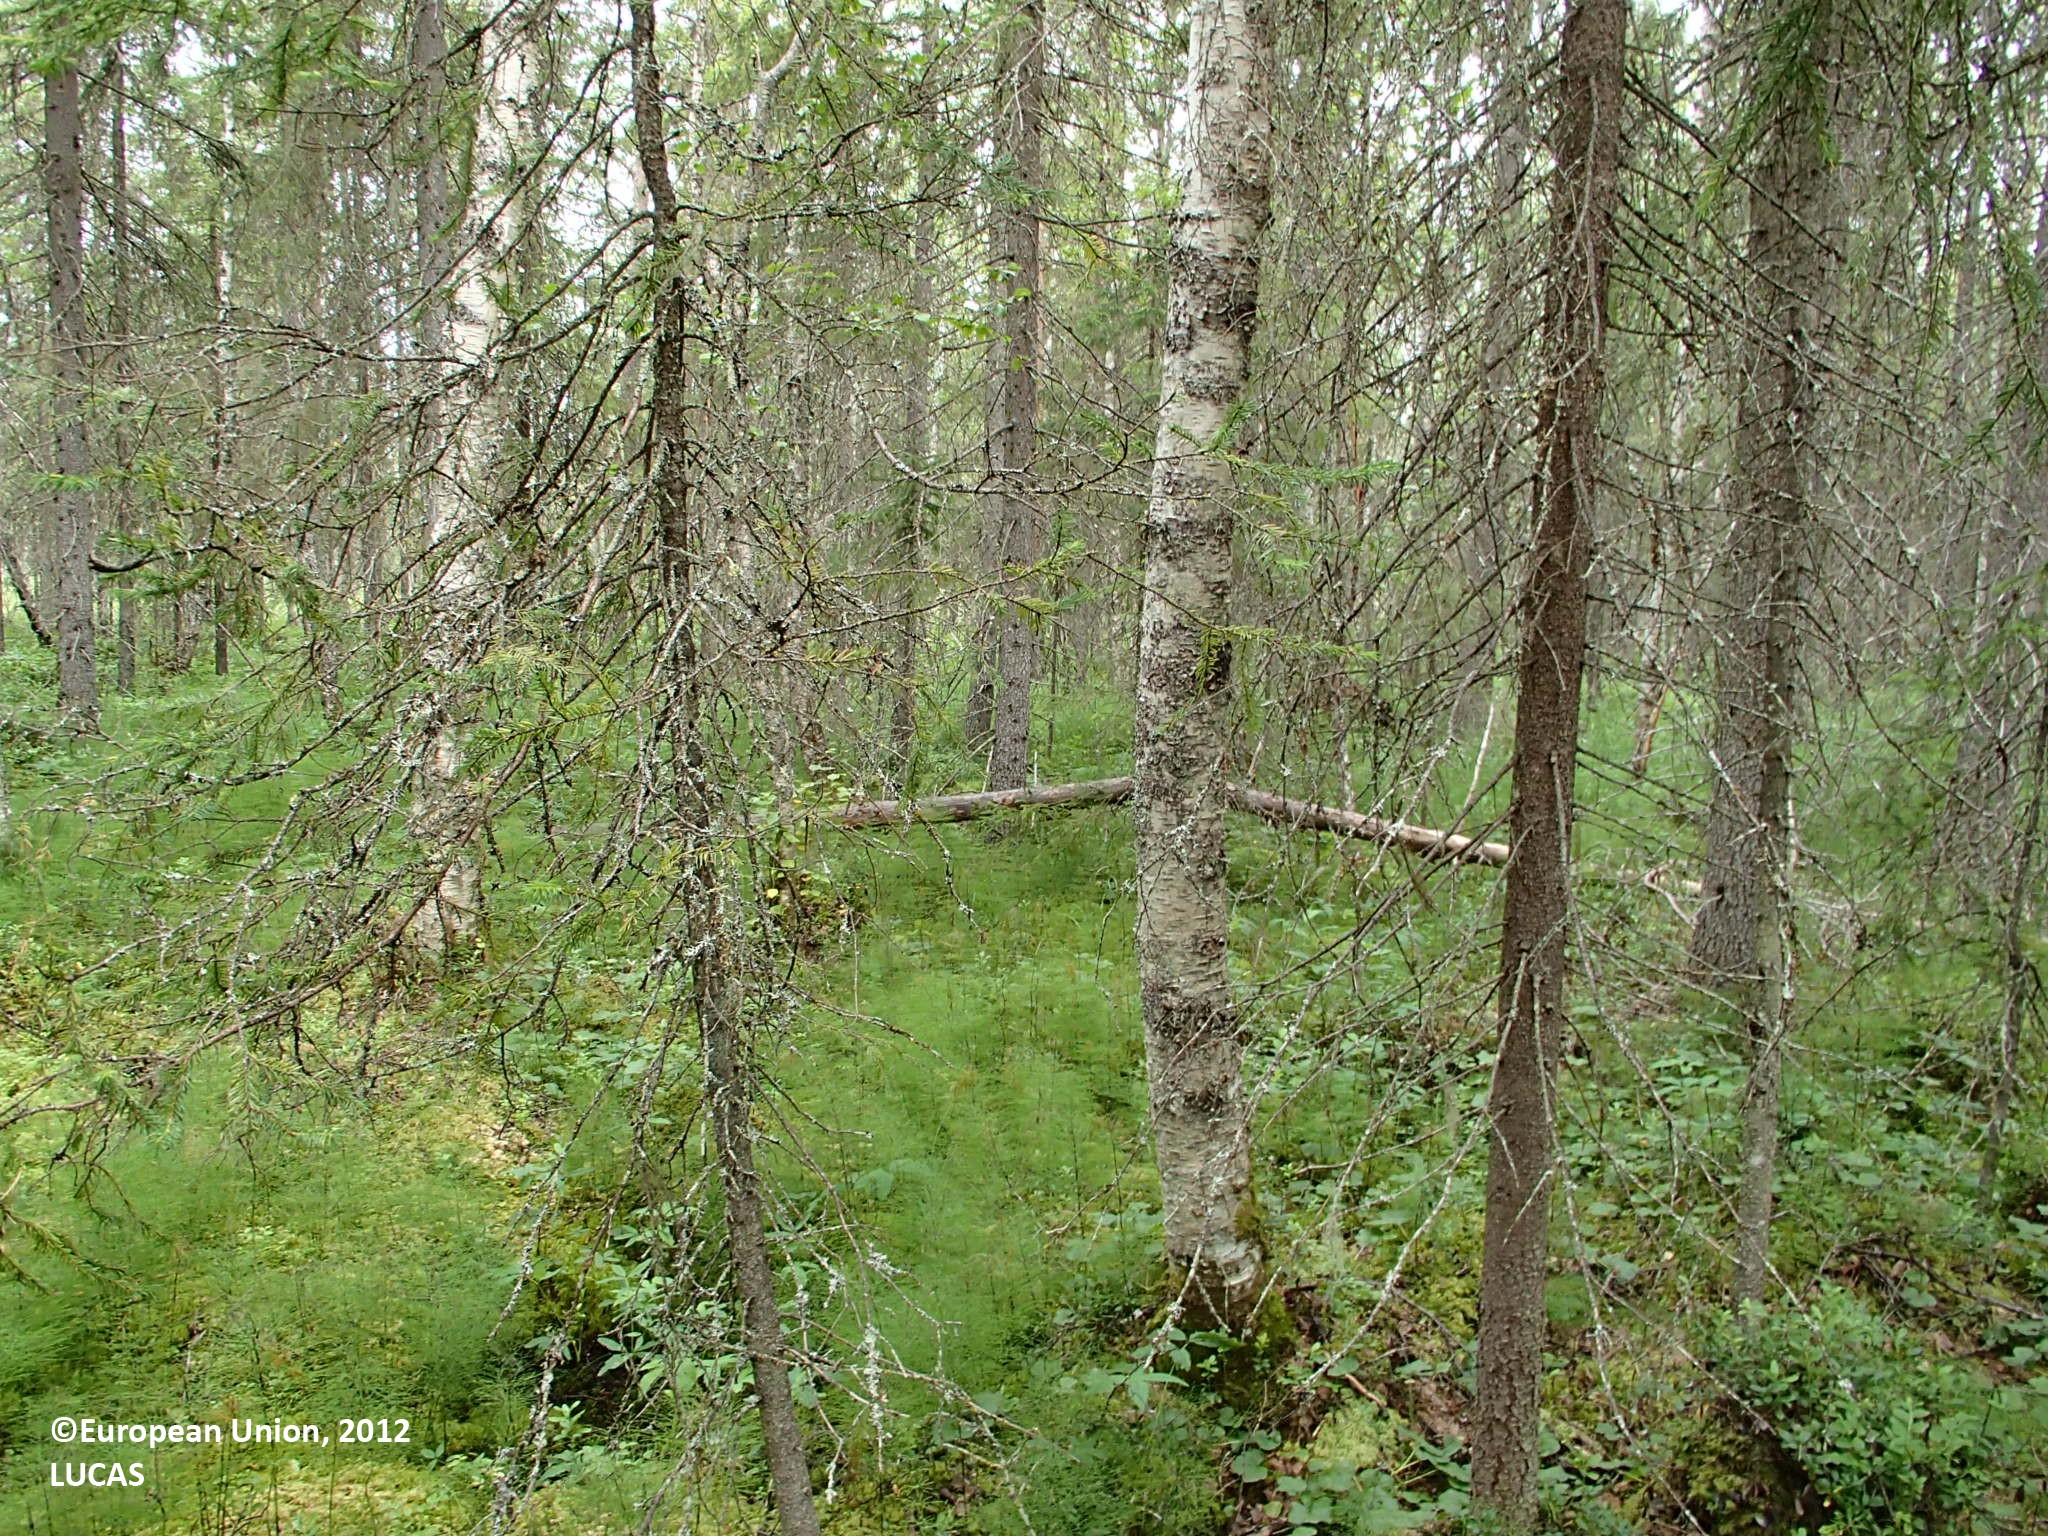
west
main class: Woodland
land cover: Other coniferous woodland
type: boreal forest
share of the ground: > 75 %
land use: Forestry
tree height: > 5 m
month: July
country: FI
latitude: 66.4151
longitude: 25.4056
